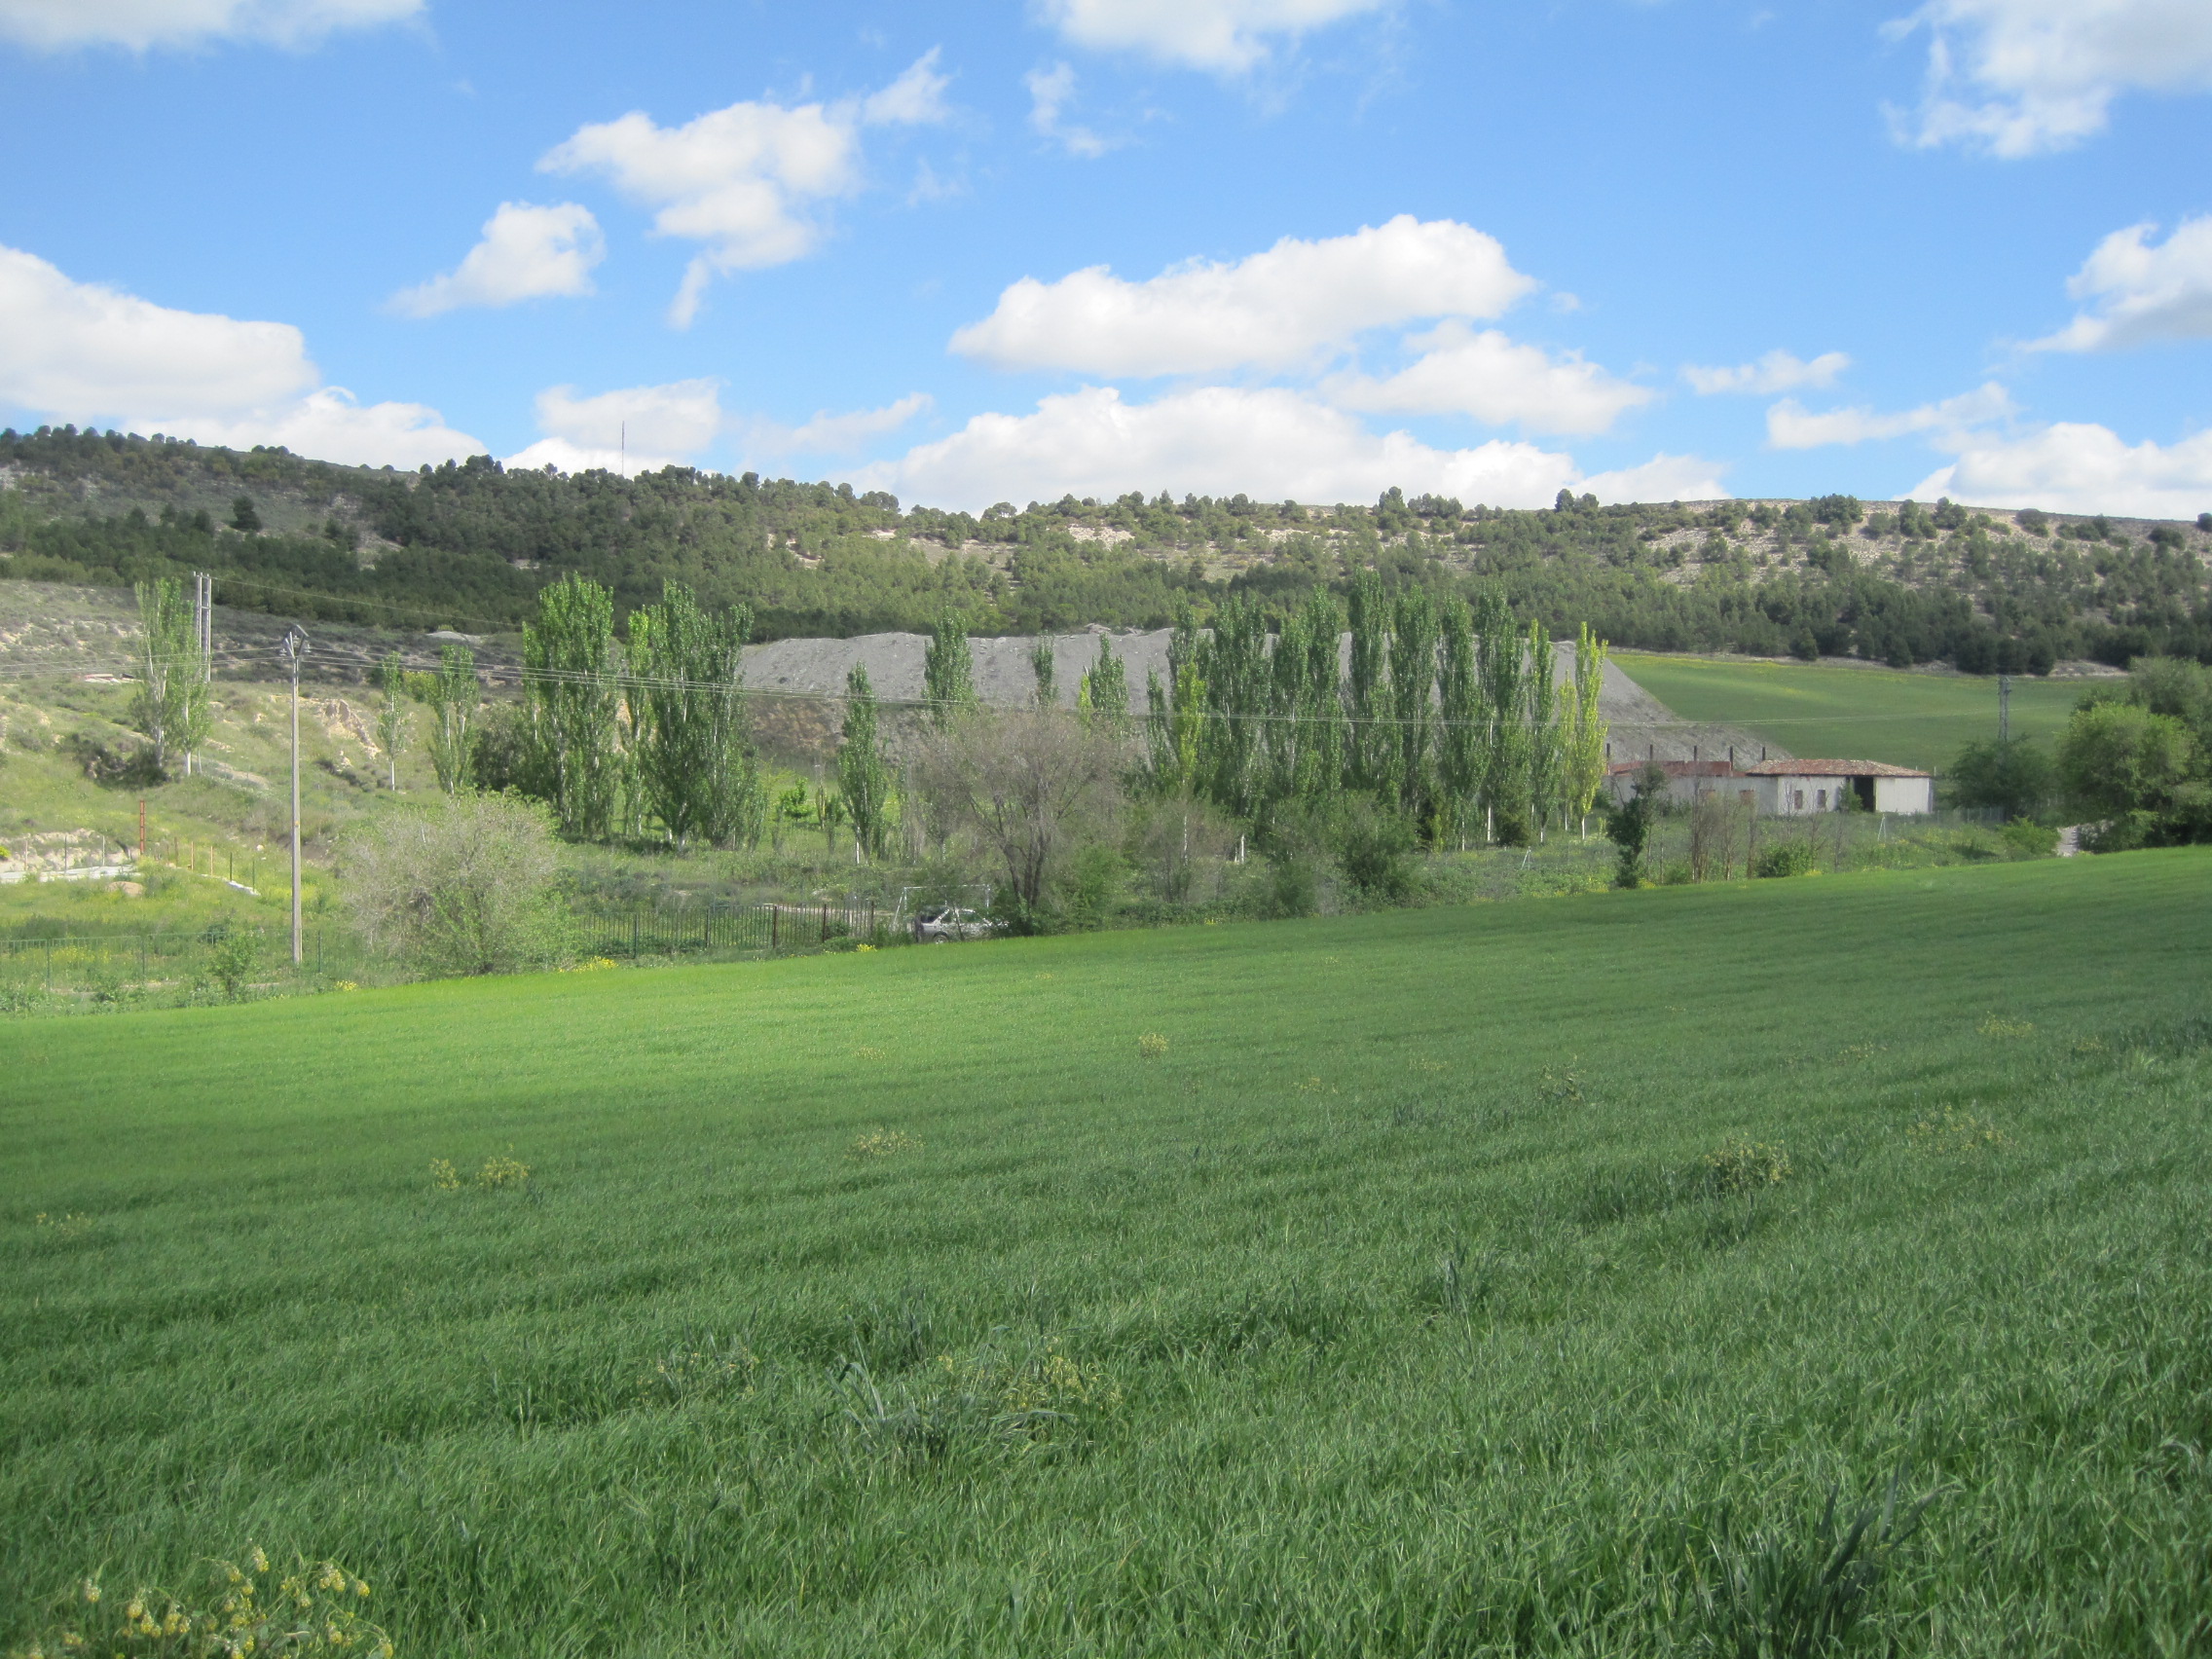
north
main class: Cropland
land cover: Barley
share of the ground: > 75 %
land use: Agriculture (excluding fallow land and kitchen gardens)
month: May
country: ES
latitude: 41.6155
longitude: -4.6727
